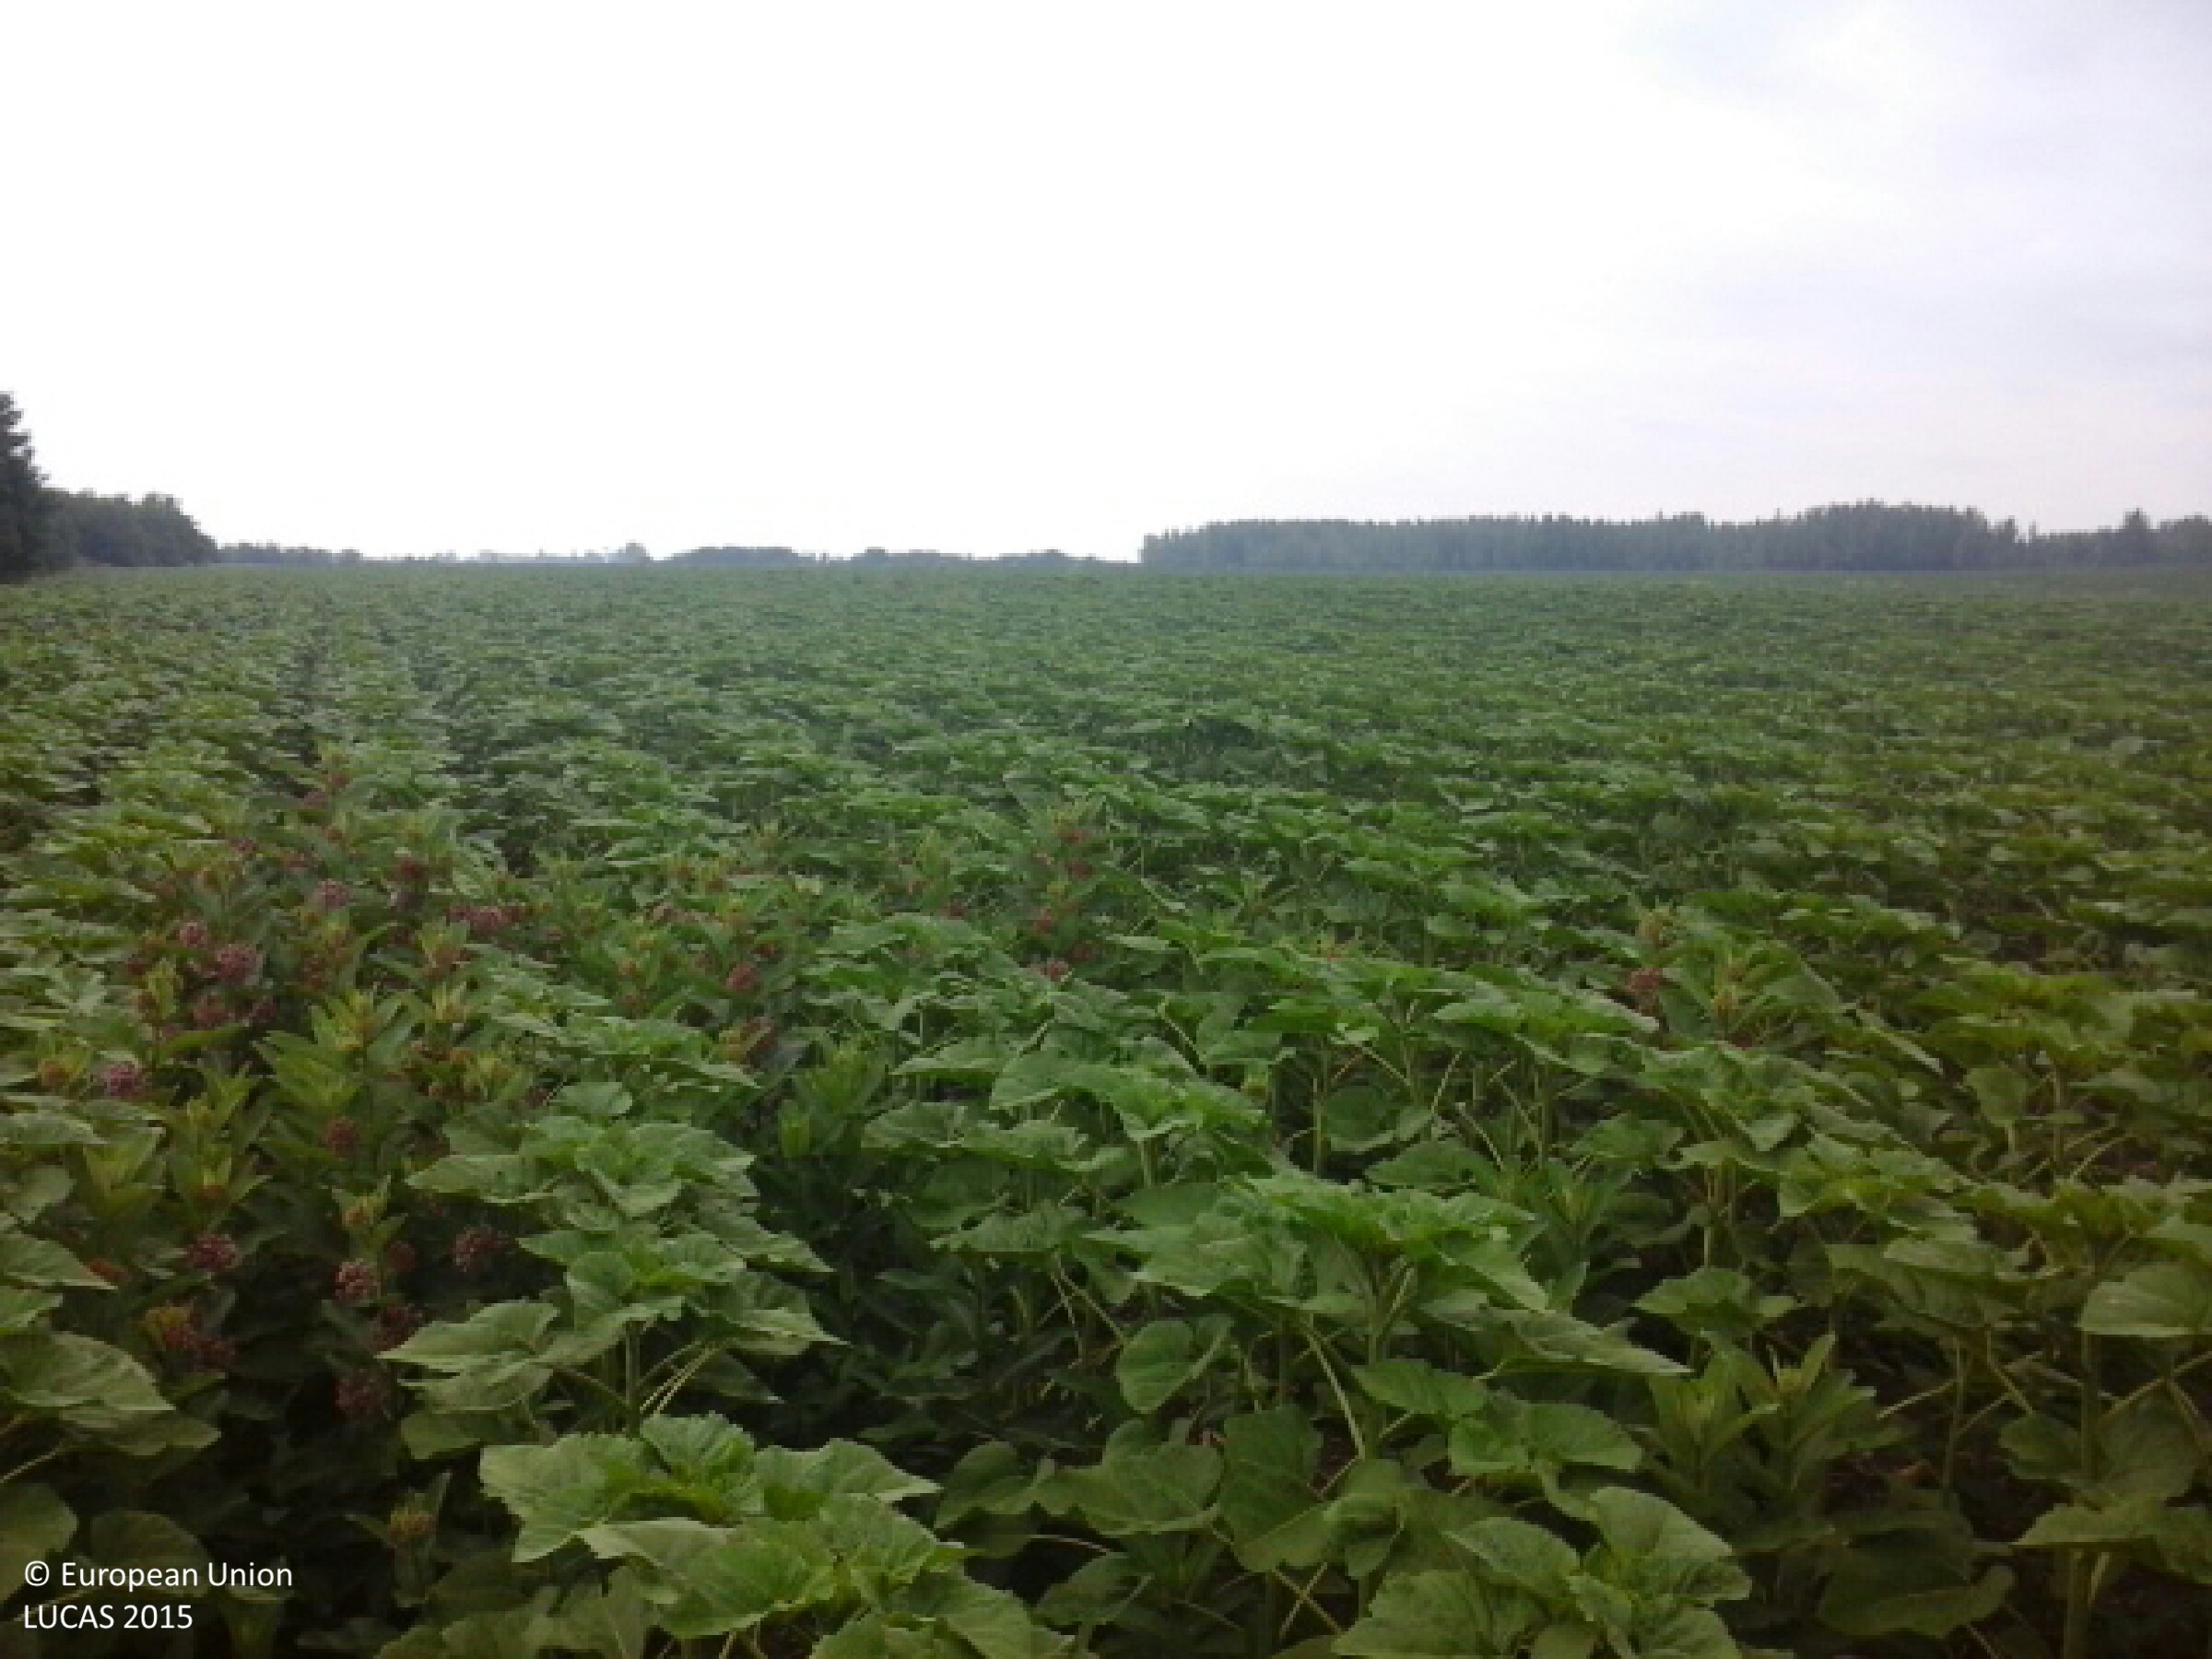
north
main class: Cropland
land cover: Sunflower
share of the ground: 50 - 75 %
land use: Agriculture (excluding fallow land and kitchen gardens)
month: June
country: HU
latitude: 48.0937
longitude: 21.8253
